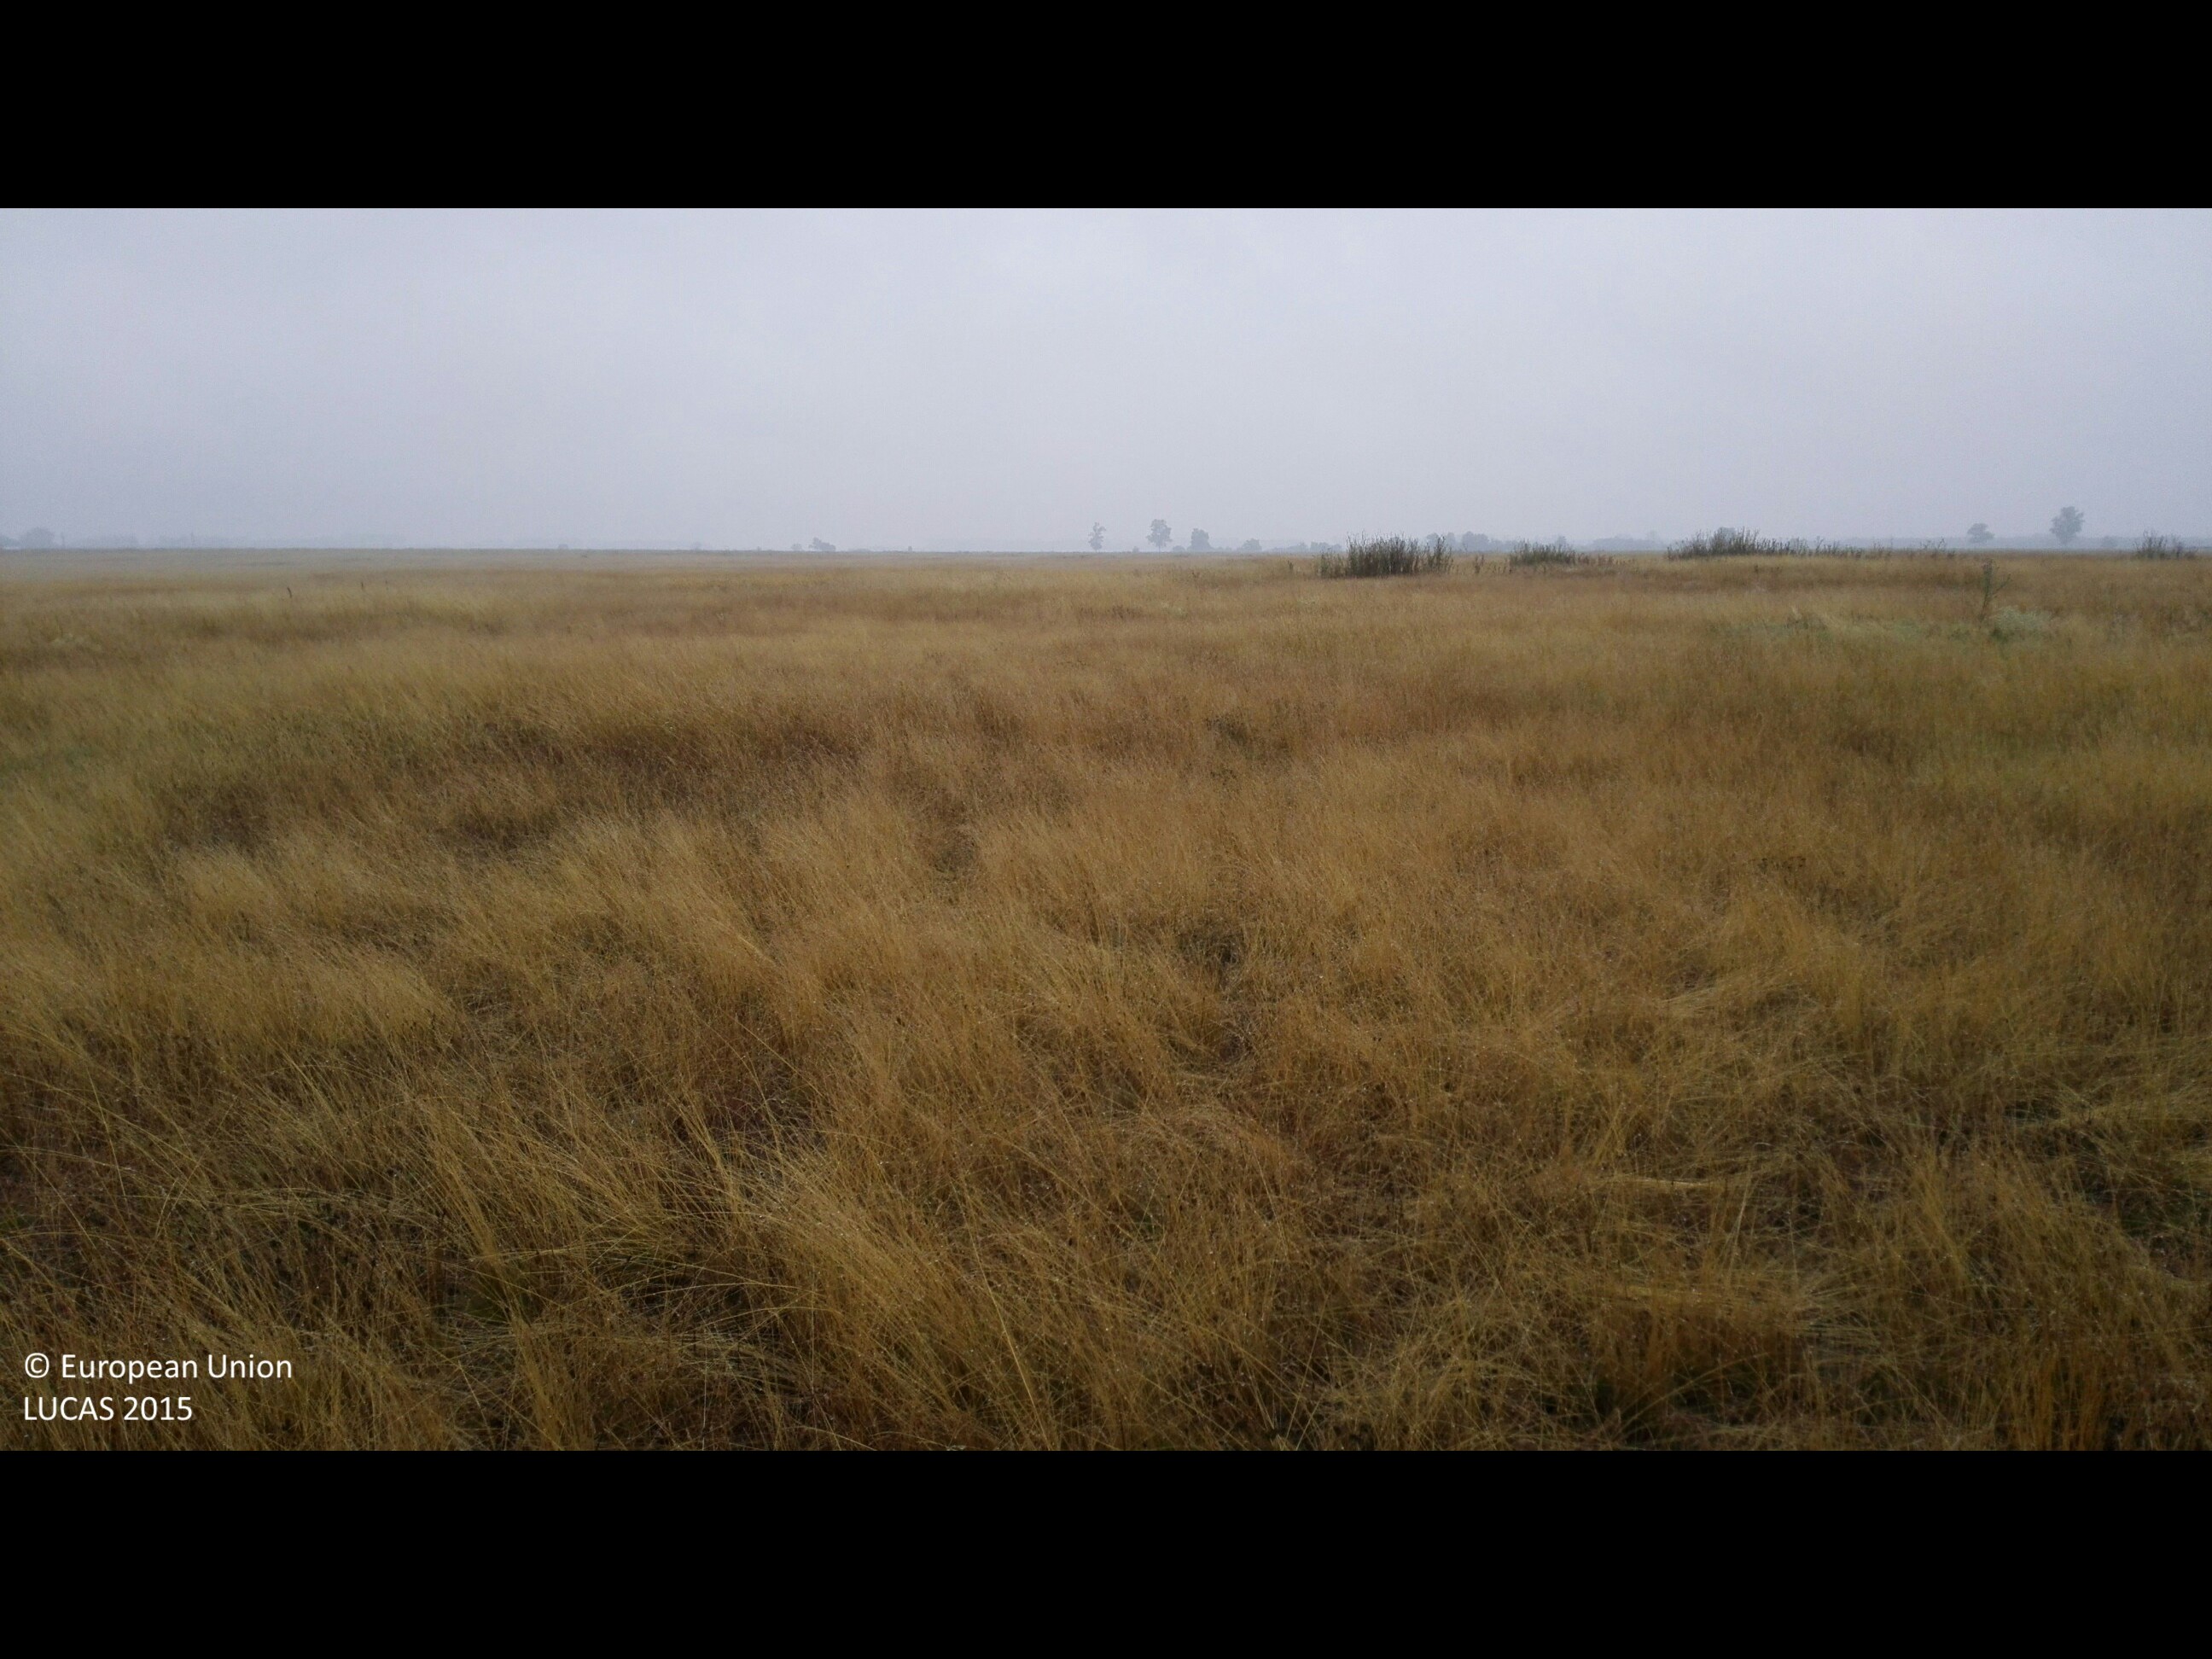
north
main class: Grassland
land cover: Grassland without tree/shrub cover
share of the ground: > 75 %
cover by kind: herbaceous plants 100 %
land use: Agriculture (excluding fallow land and kitchen gardens)
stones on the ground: < 10 %
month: August
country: HU
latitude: 47.1767
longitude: 21.5609
